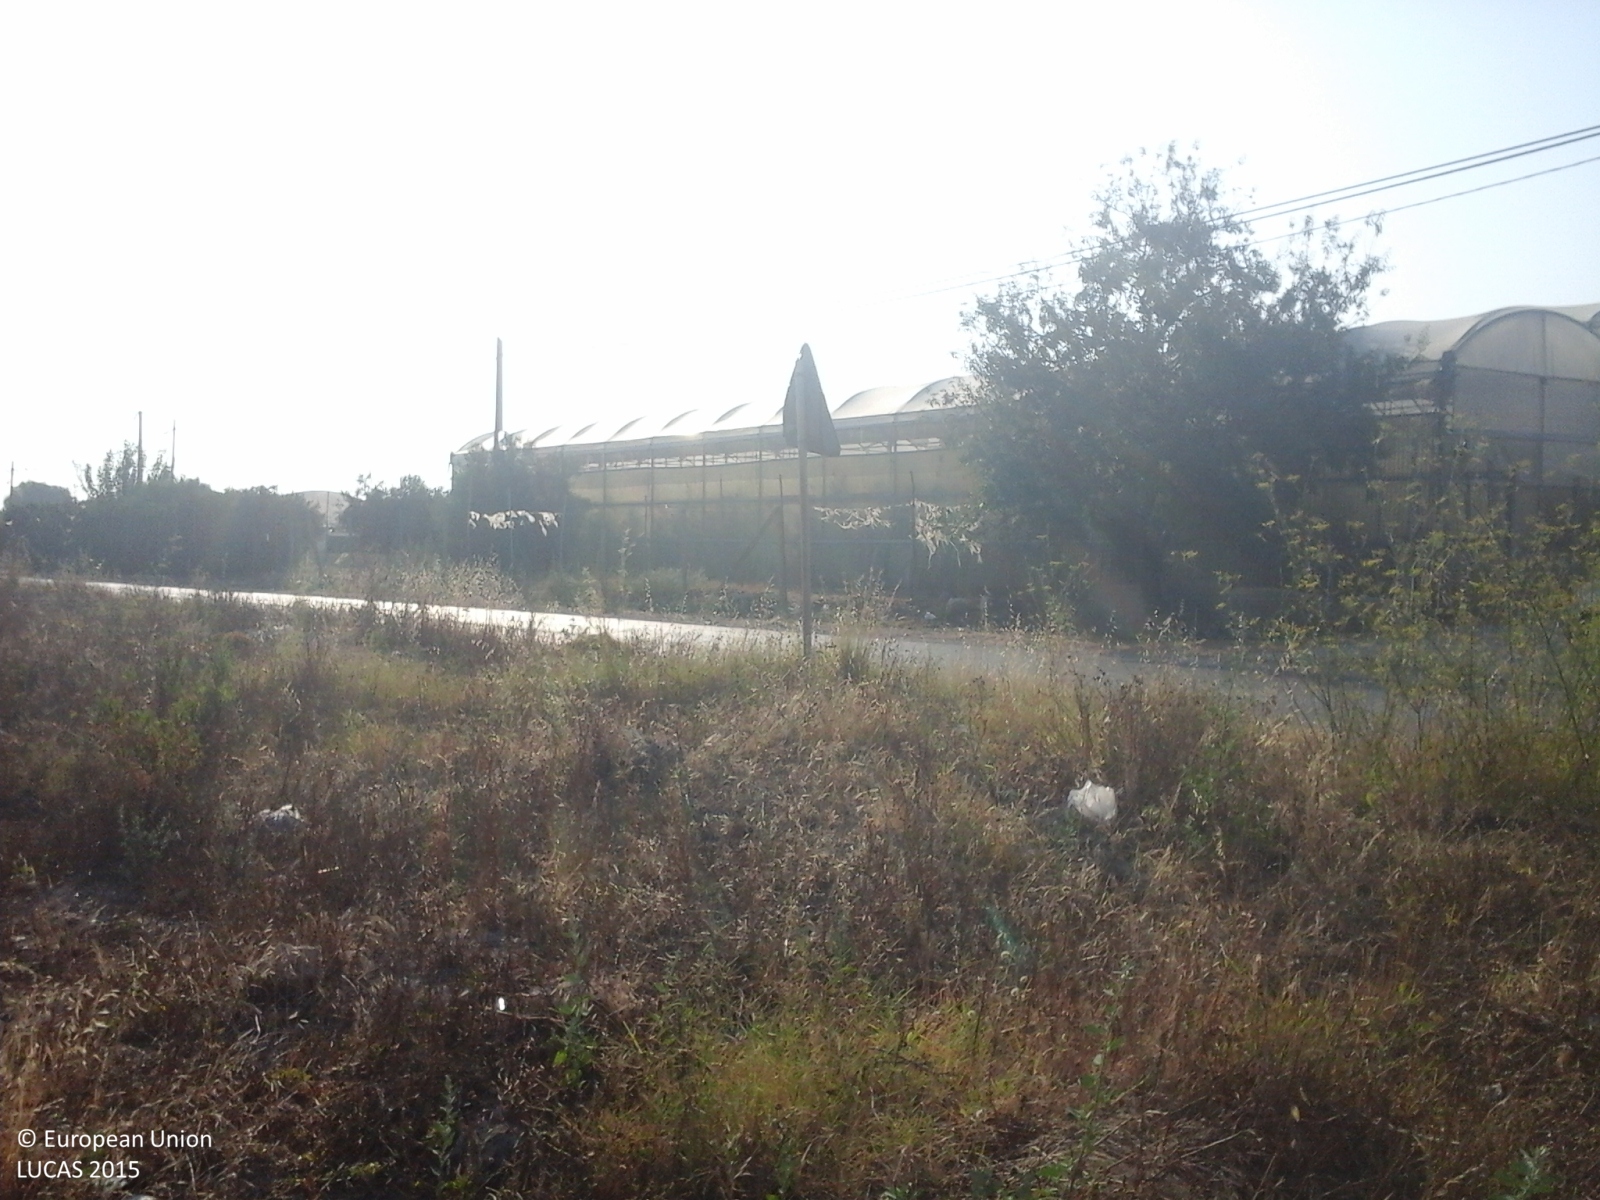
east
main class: Grassland
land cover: Grassland without tree/shrub cover
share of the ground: > 75 %
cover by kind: herbaceous plants 100 %
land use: Abandoned areas
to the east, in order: Grassland without tree/shrub cover; Paved roads, cycling and walking lanes; Managed hedges; Grassland without tree/shrub cover; Artificial constructions in urban areas; Olive groves; Fences; Spontaneously vegetated surfaces; Olive groves; Artificial constructions in urban areas; Spontaneously vegetated surfaces; Artificial constructions; Olive groves; Managed hedges
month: July
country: IT
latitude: 36.9909
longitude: 14.4031
